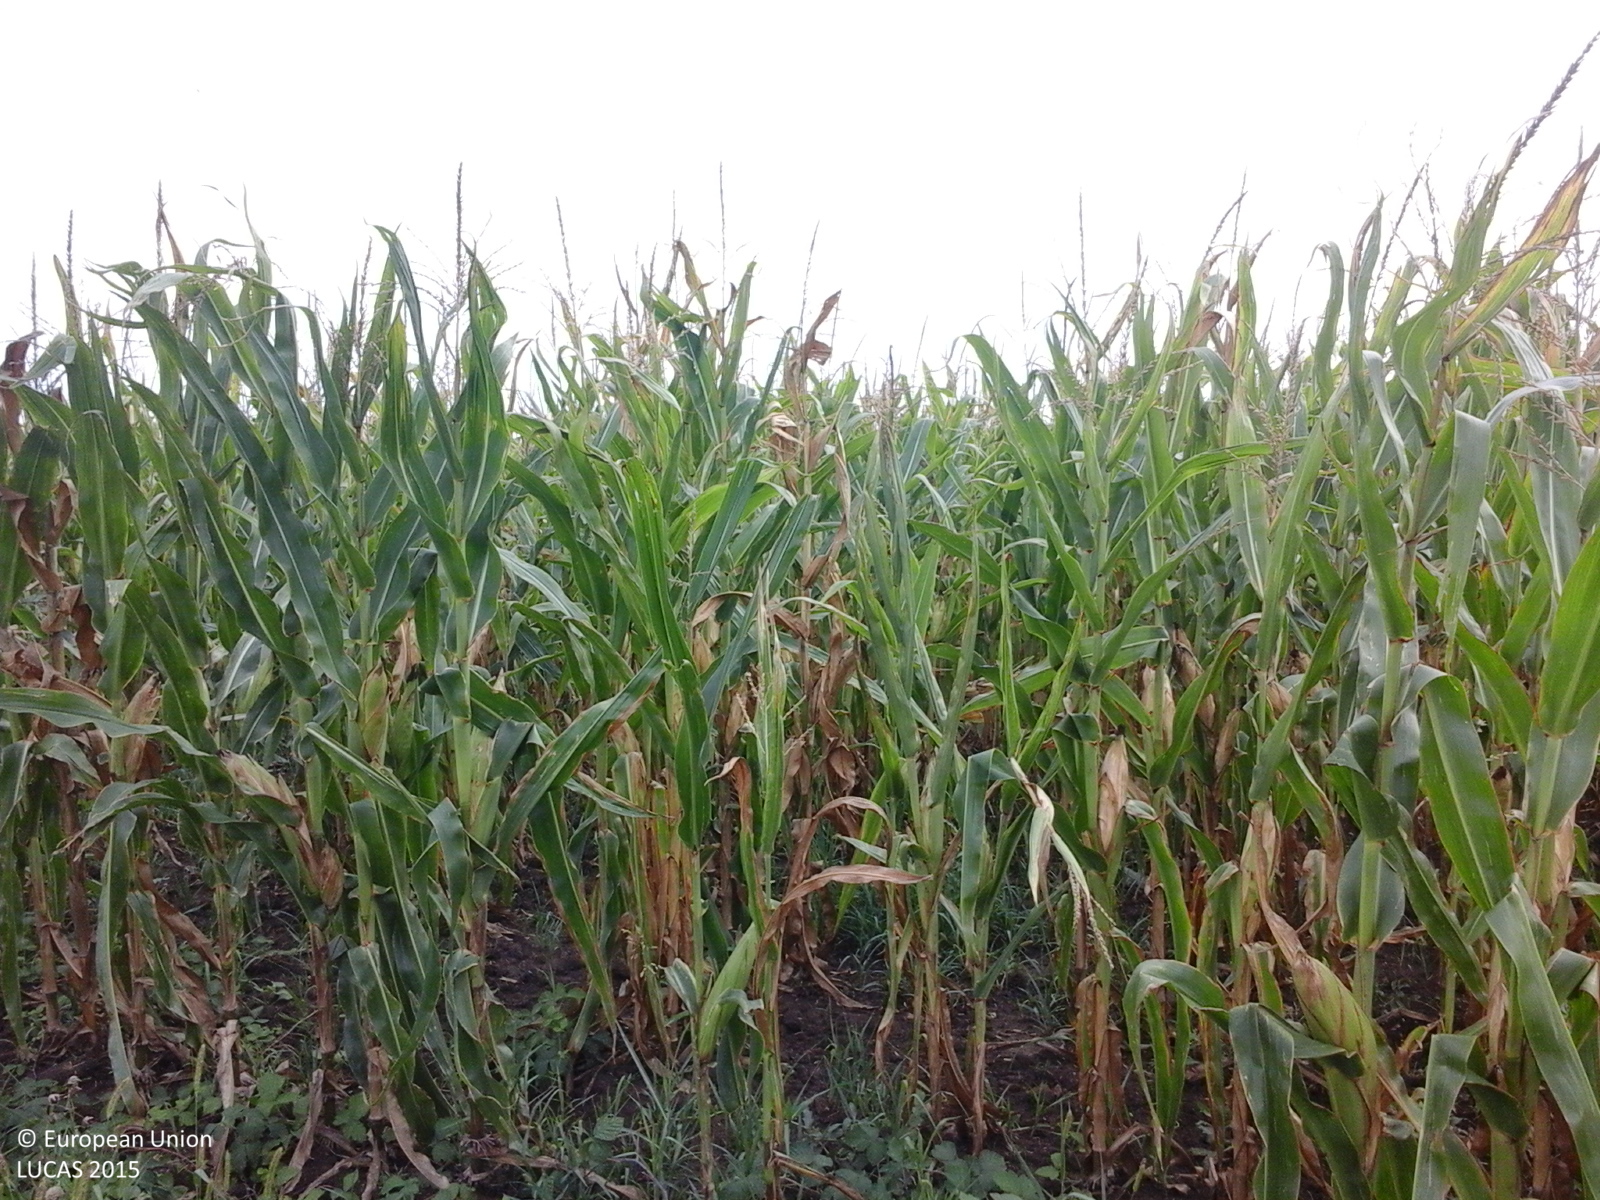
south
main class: Cropland
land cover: Maize
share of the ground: > 75 %
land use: Agriculture (excluding fallow land and kitchen gardens)
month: August
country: RO
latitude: 46.2175
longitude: 21.3515
